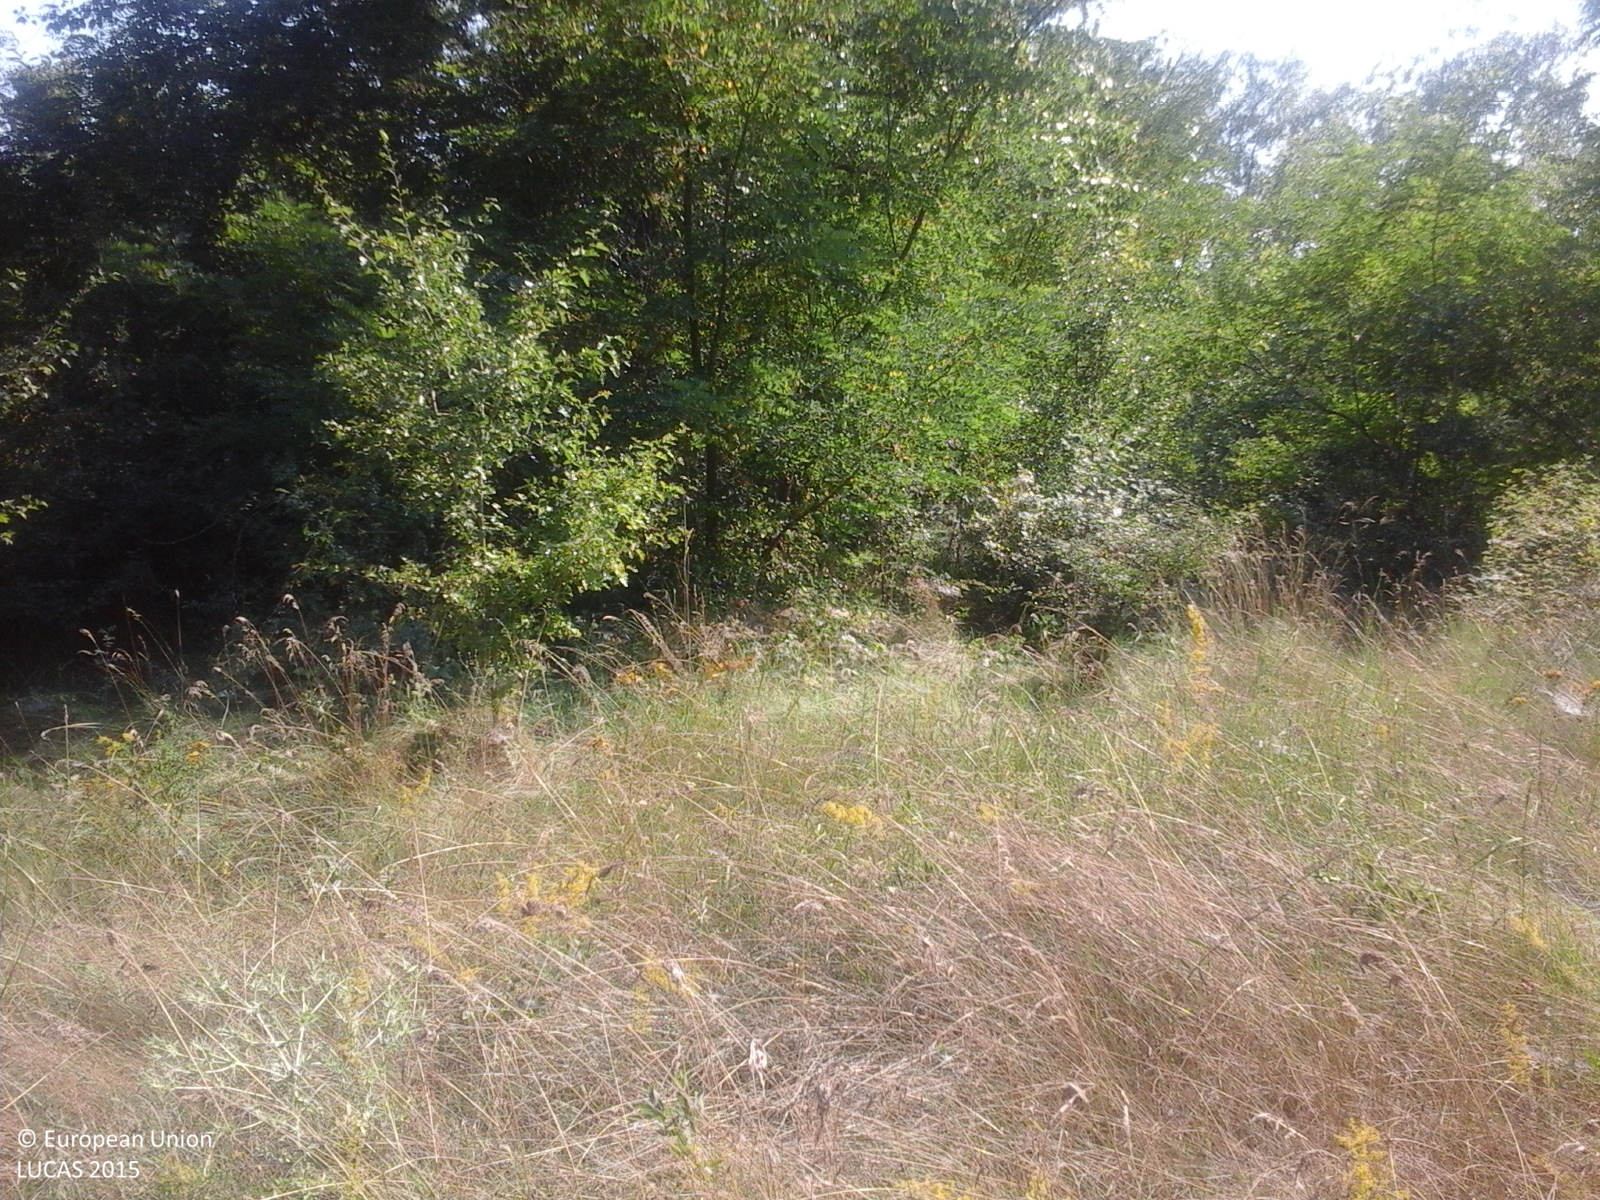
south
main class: Grassland
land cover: Grassland with sparse tree/shrub cover
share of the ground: > 75 %
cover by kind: herbaceous plants 85 %, shrubs 10 %, broadleaved forest trees 5 %
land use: Agriculture (excluding fallow land and kitchen gardens)
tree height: < 5 m
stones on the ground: < 10 %
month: July
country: RO
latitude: 44.6611
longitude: 25.3889
